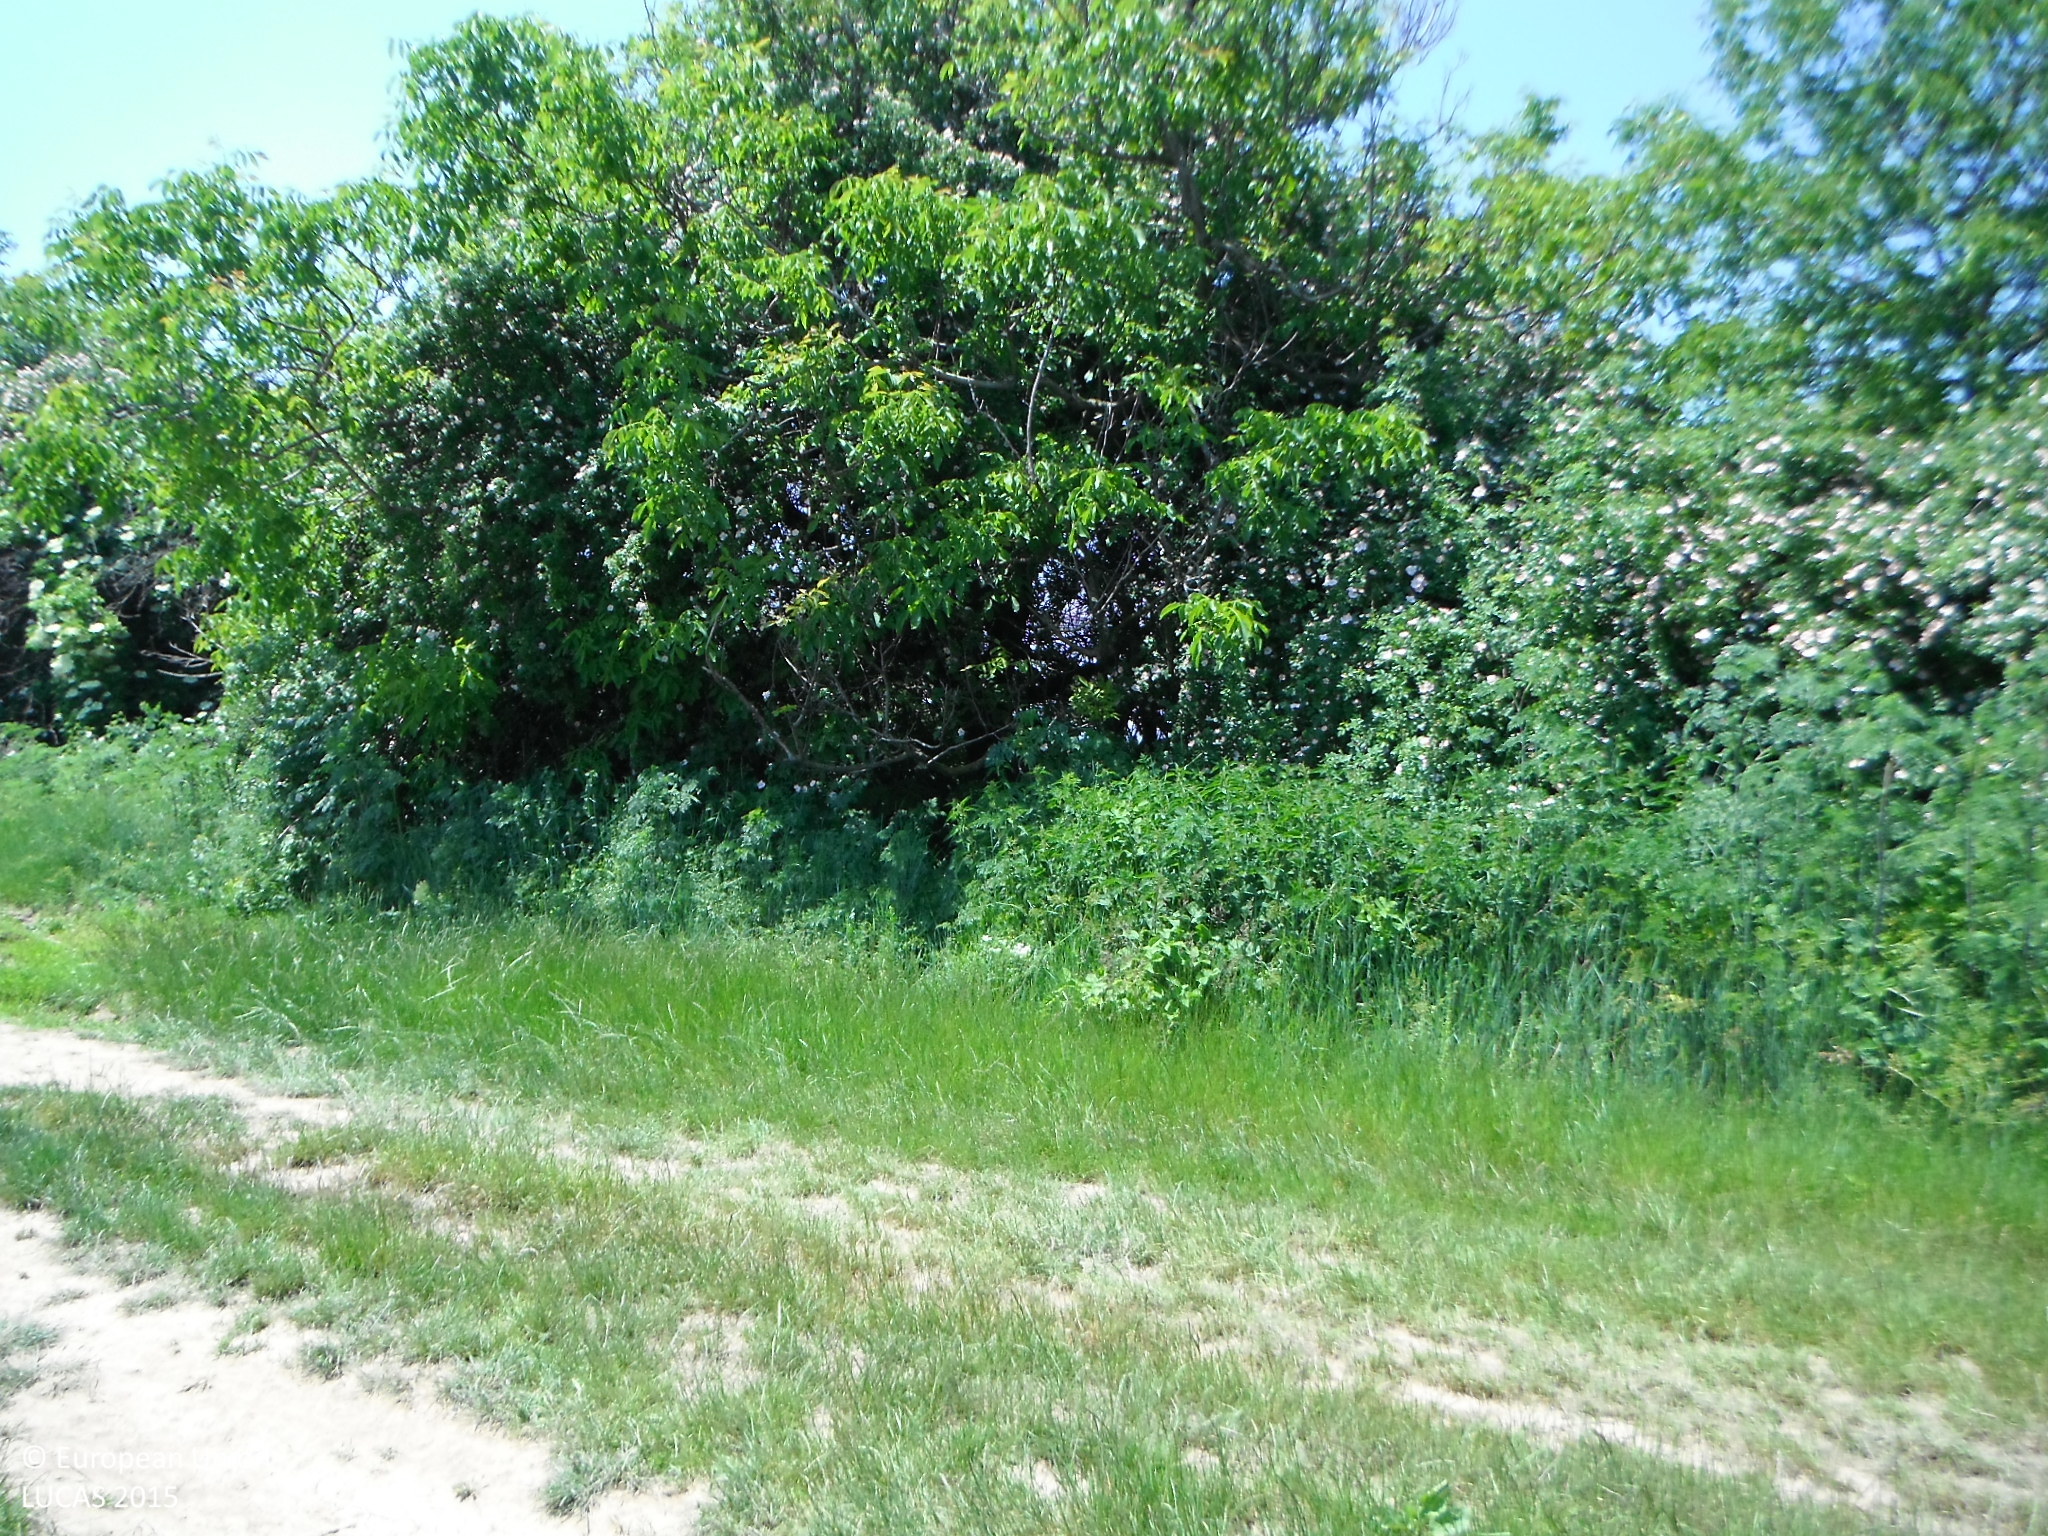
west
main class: Cropland
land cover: Common wheat
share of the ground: > 75 %
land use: Agriculture (excluding fallow land and kitchen gardens)
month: June
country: SK
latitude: 48.3171
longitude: 17.4132
